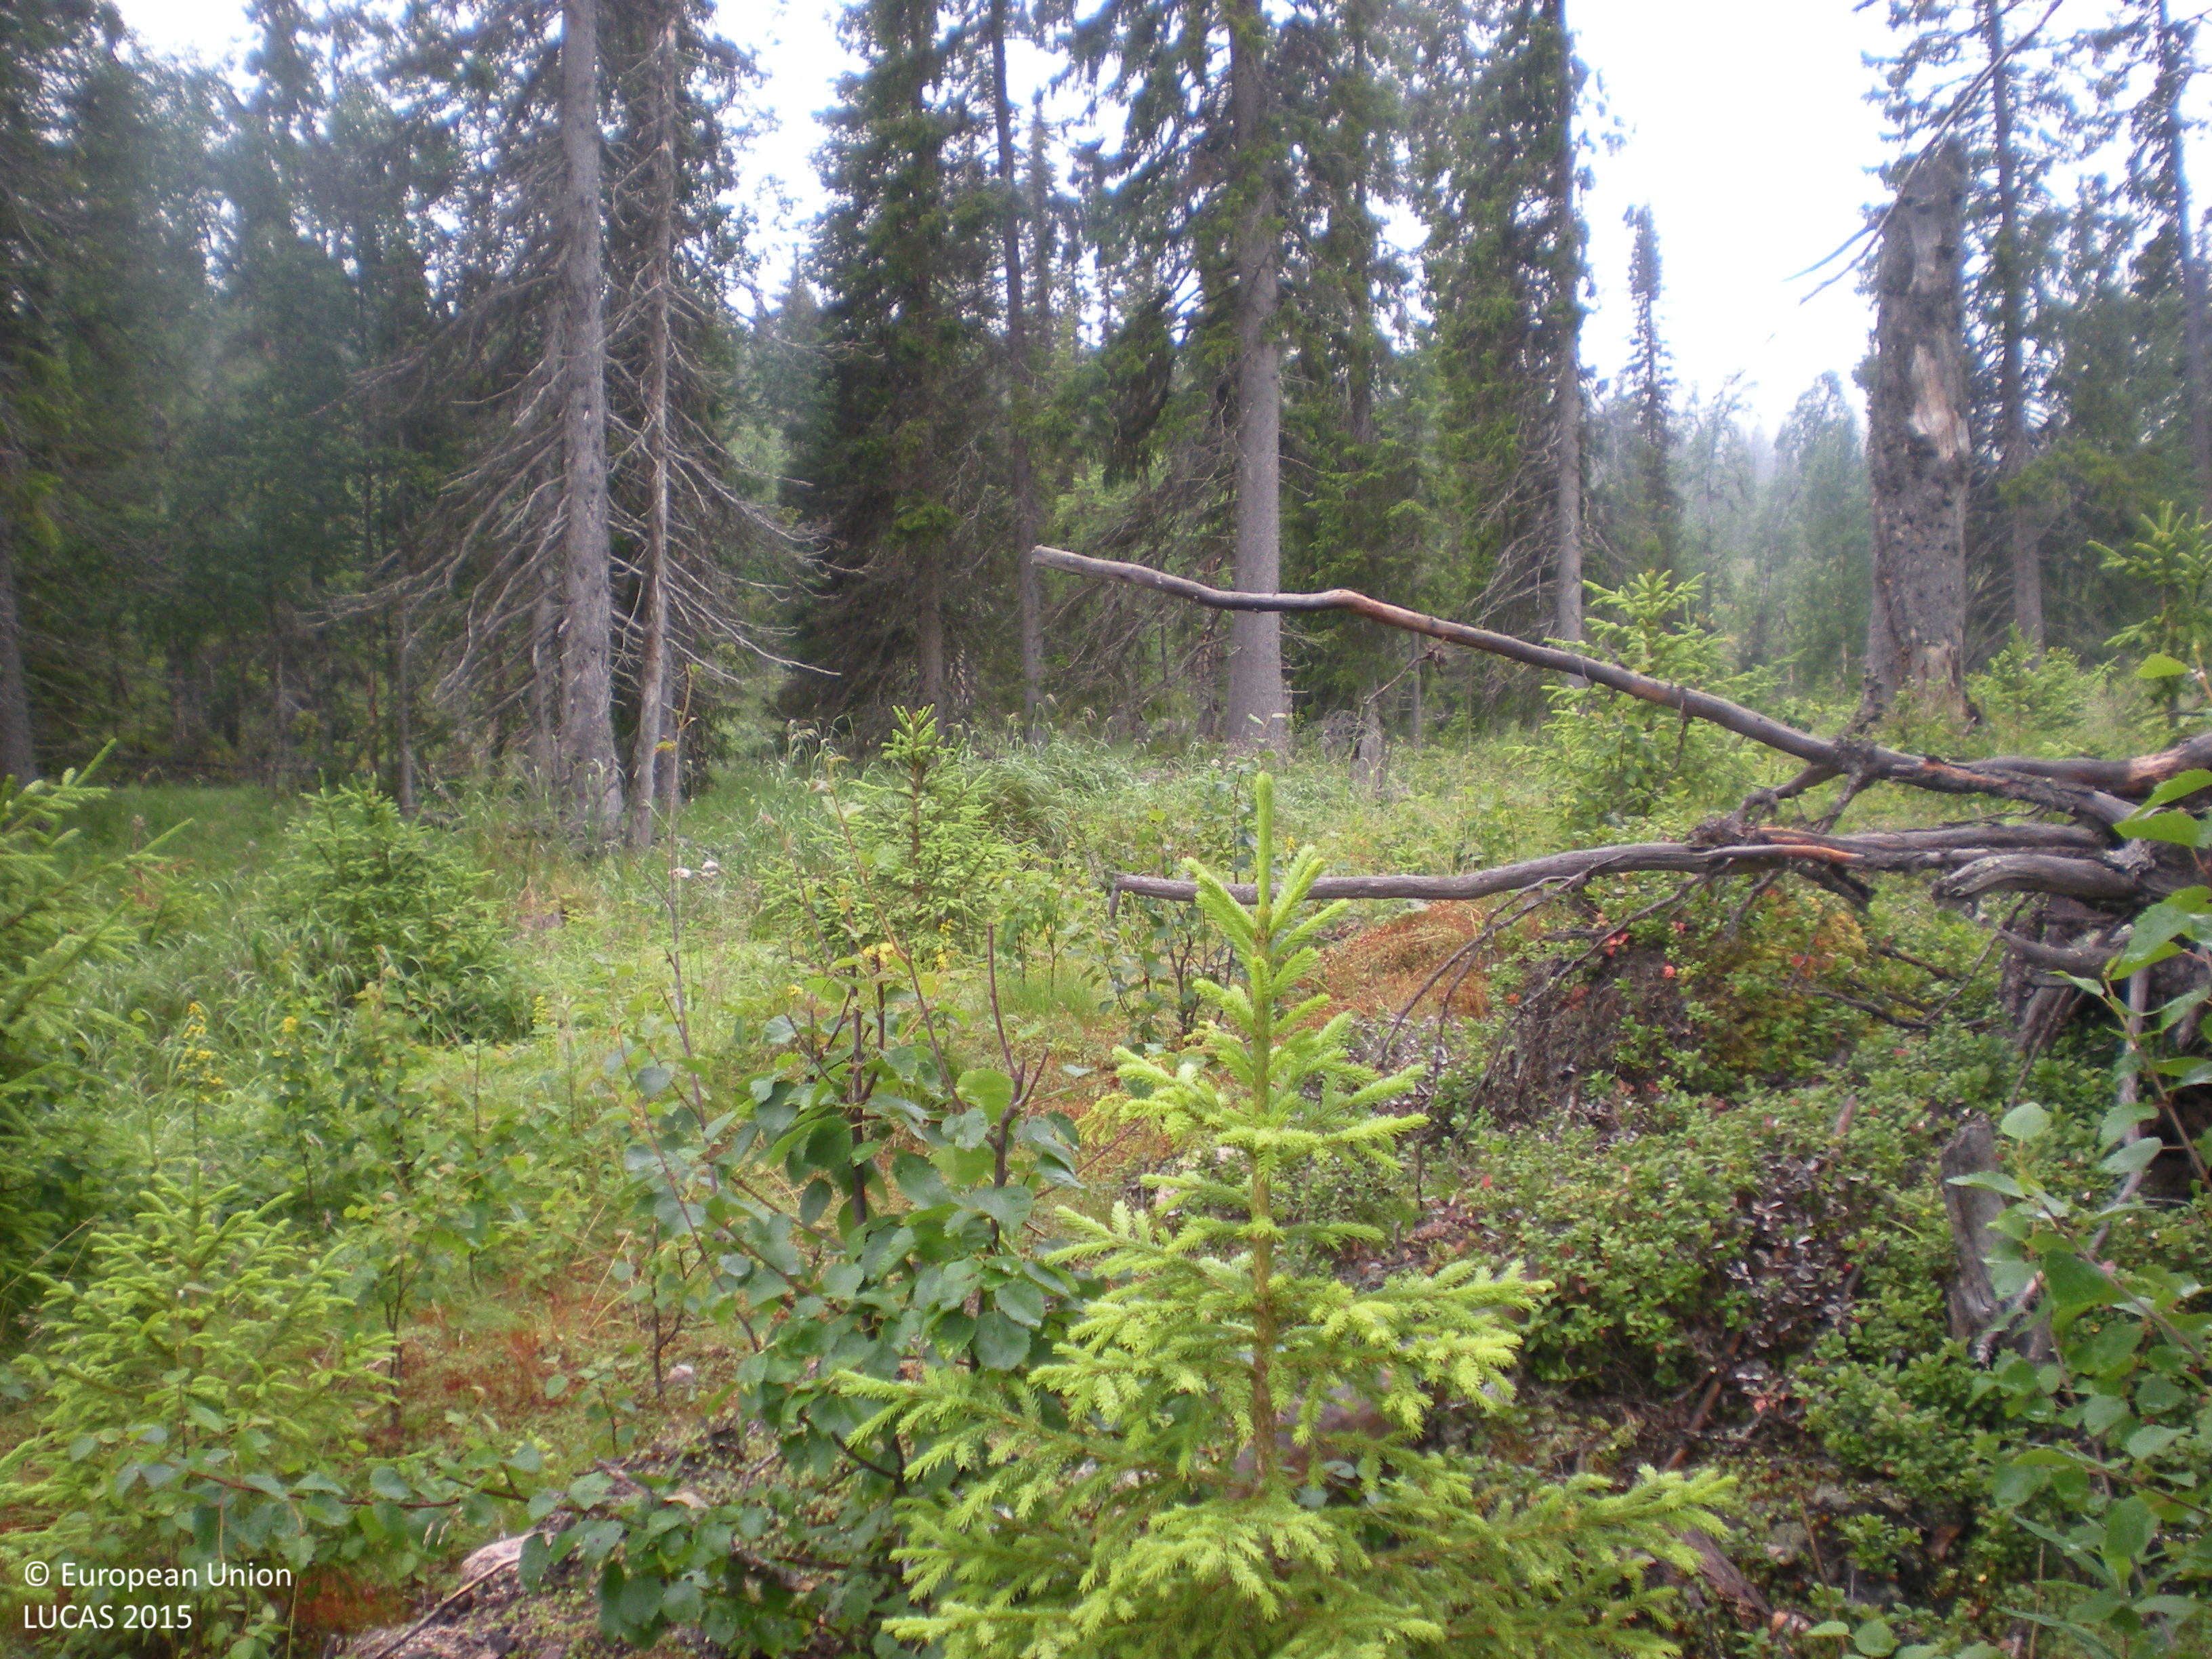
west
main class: Woodland
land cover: Spruce dominated mixed woodland
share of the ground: 50 - 75 %
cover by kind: coniferous forest trees 40 %, shrubs 25 %, broadleaved forest trees 20 %, lichens and mosses 10 %, herbaceous plants 5 %
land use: Forestry
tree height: > 5 m
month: August
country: SE
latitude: 66.0910
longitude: 18.2910
